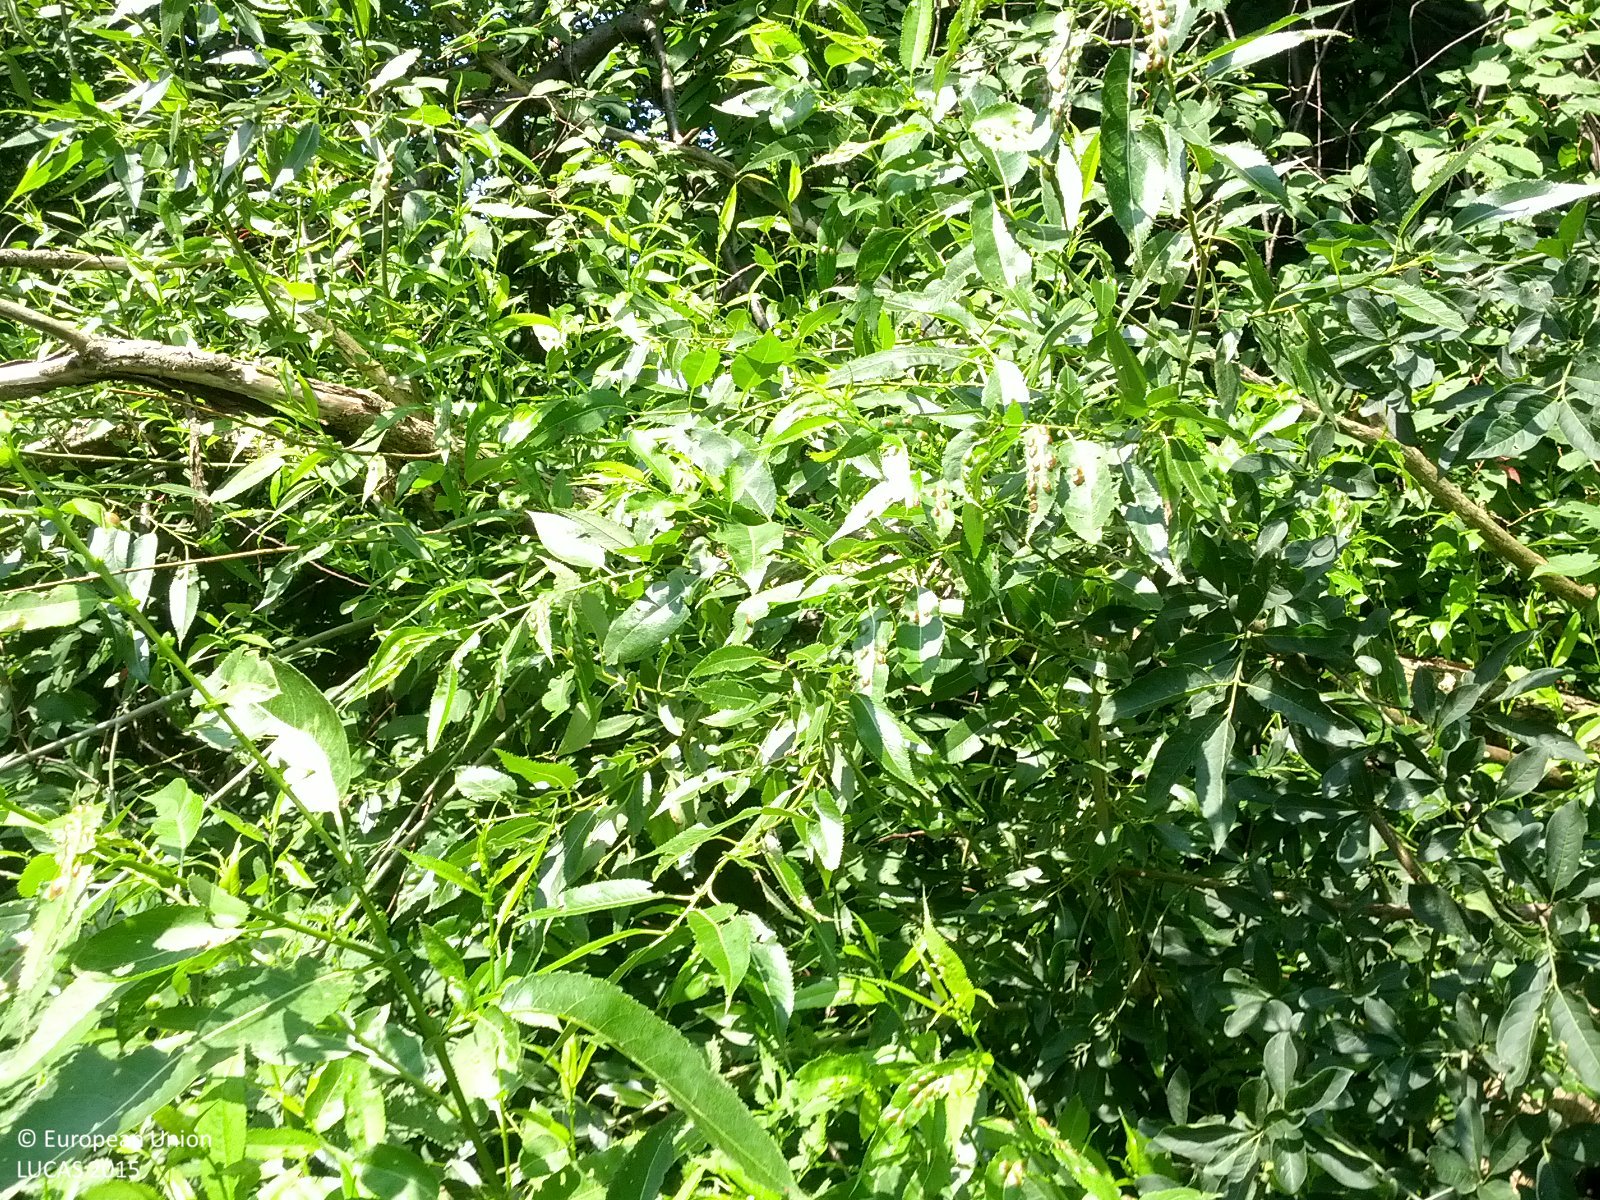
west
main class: Woodland
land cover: Broadleaved woodland
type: floodplain forest
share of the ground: > 75 %
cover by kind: broadleaved forest trees 75 %, herbaceous plants 20 %, shrubs 5 %
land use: Semi-natural and natural areas not in use
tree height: > 5 m
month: July
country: AT
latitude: 47.2429
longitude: 16.0921
